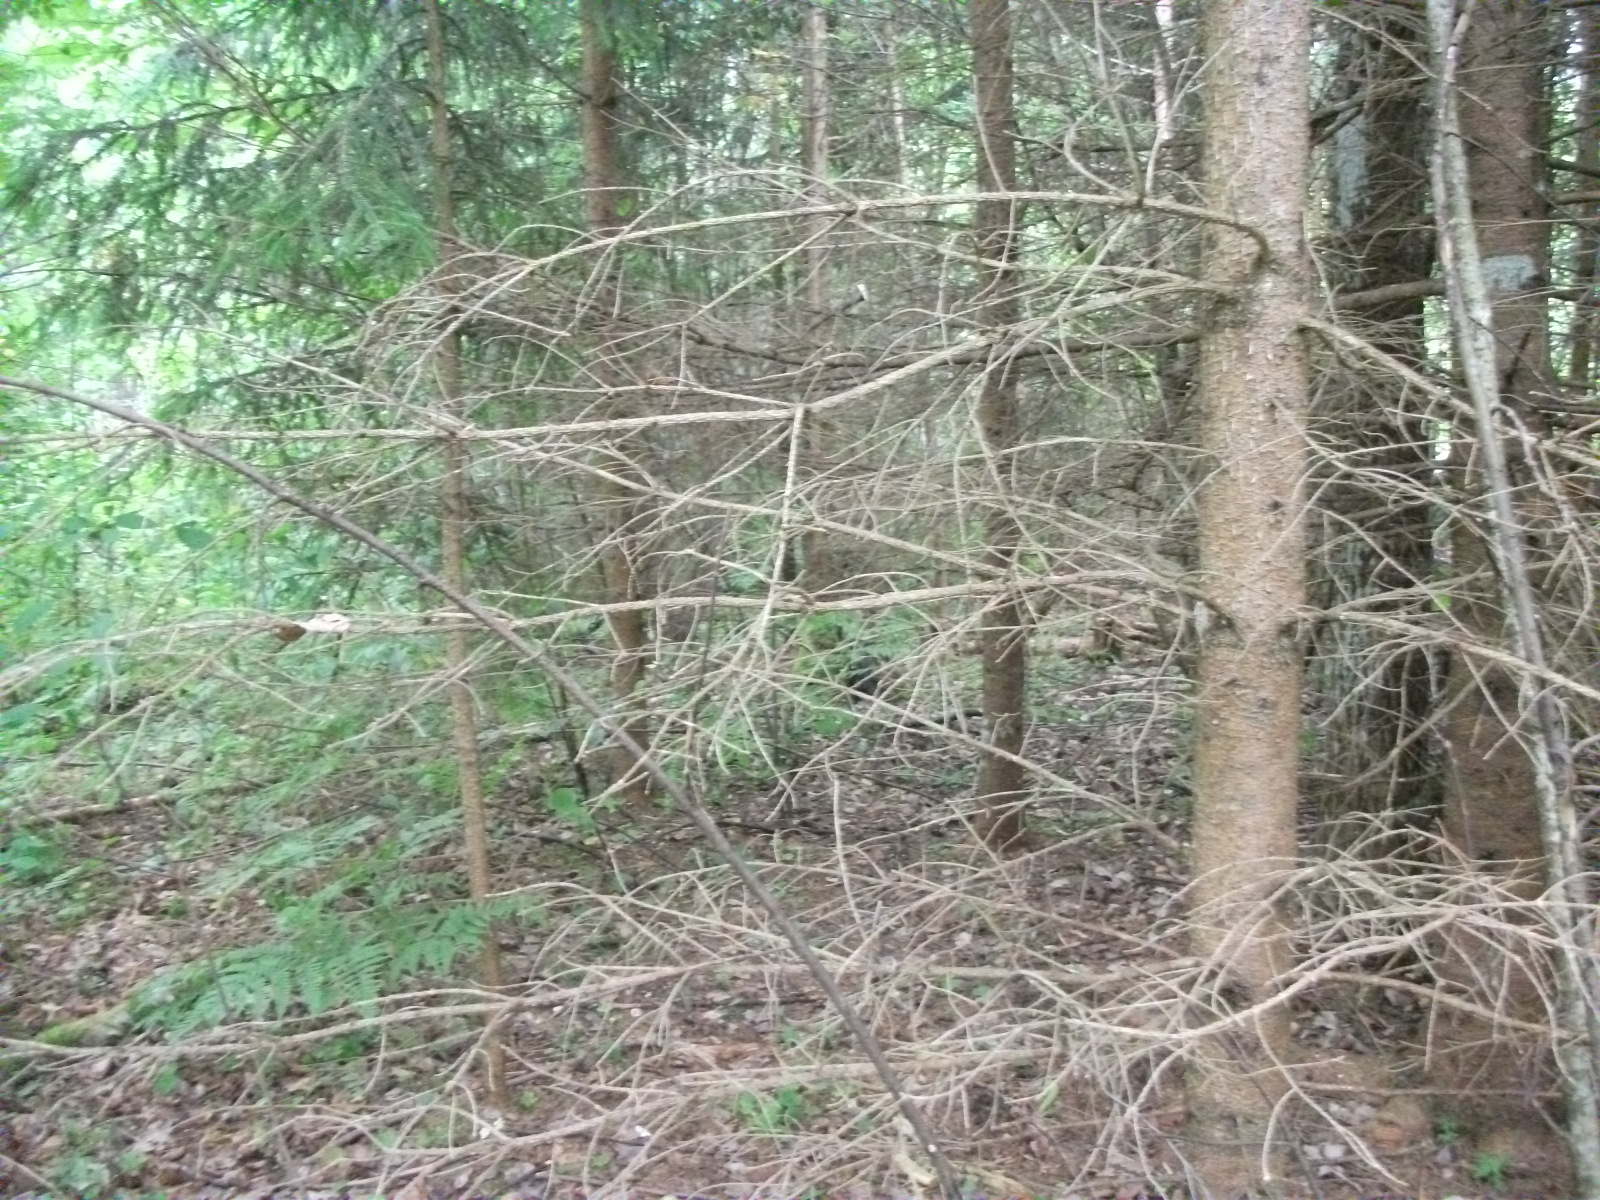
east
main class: Woodland
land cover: Spruce dominated coniferous woodland
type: hemiboreal forest and nemoral coniferous forest and mixed broadleaved-coniferous forest
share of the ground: > 75 %
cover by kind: coniferous forest trees 90 %, herbaceous plants 5 %, unconsolidated bare surface 5 %
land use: Forestry
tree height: > 5 m
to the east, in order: Spruce dominated coniferous woodland; Broadleaved woodland; Shrubland with sparse tree cover; Broadleaved woodland; Shrubland with sparse tree cover
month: July
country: LV
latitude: 57.1833
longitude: 26.5408
